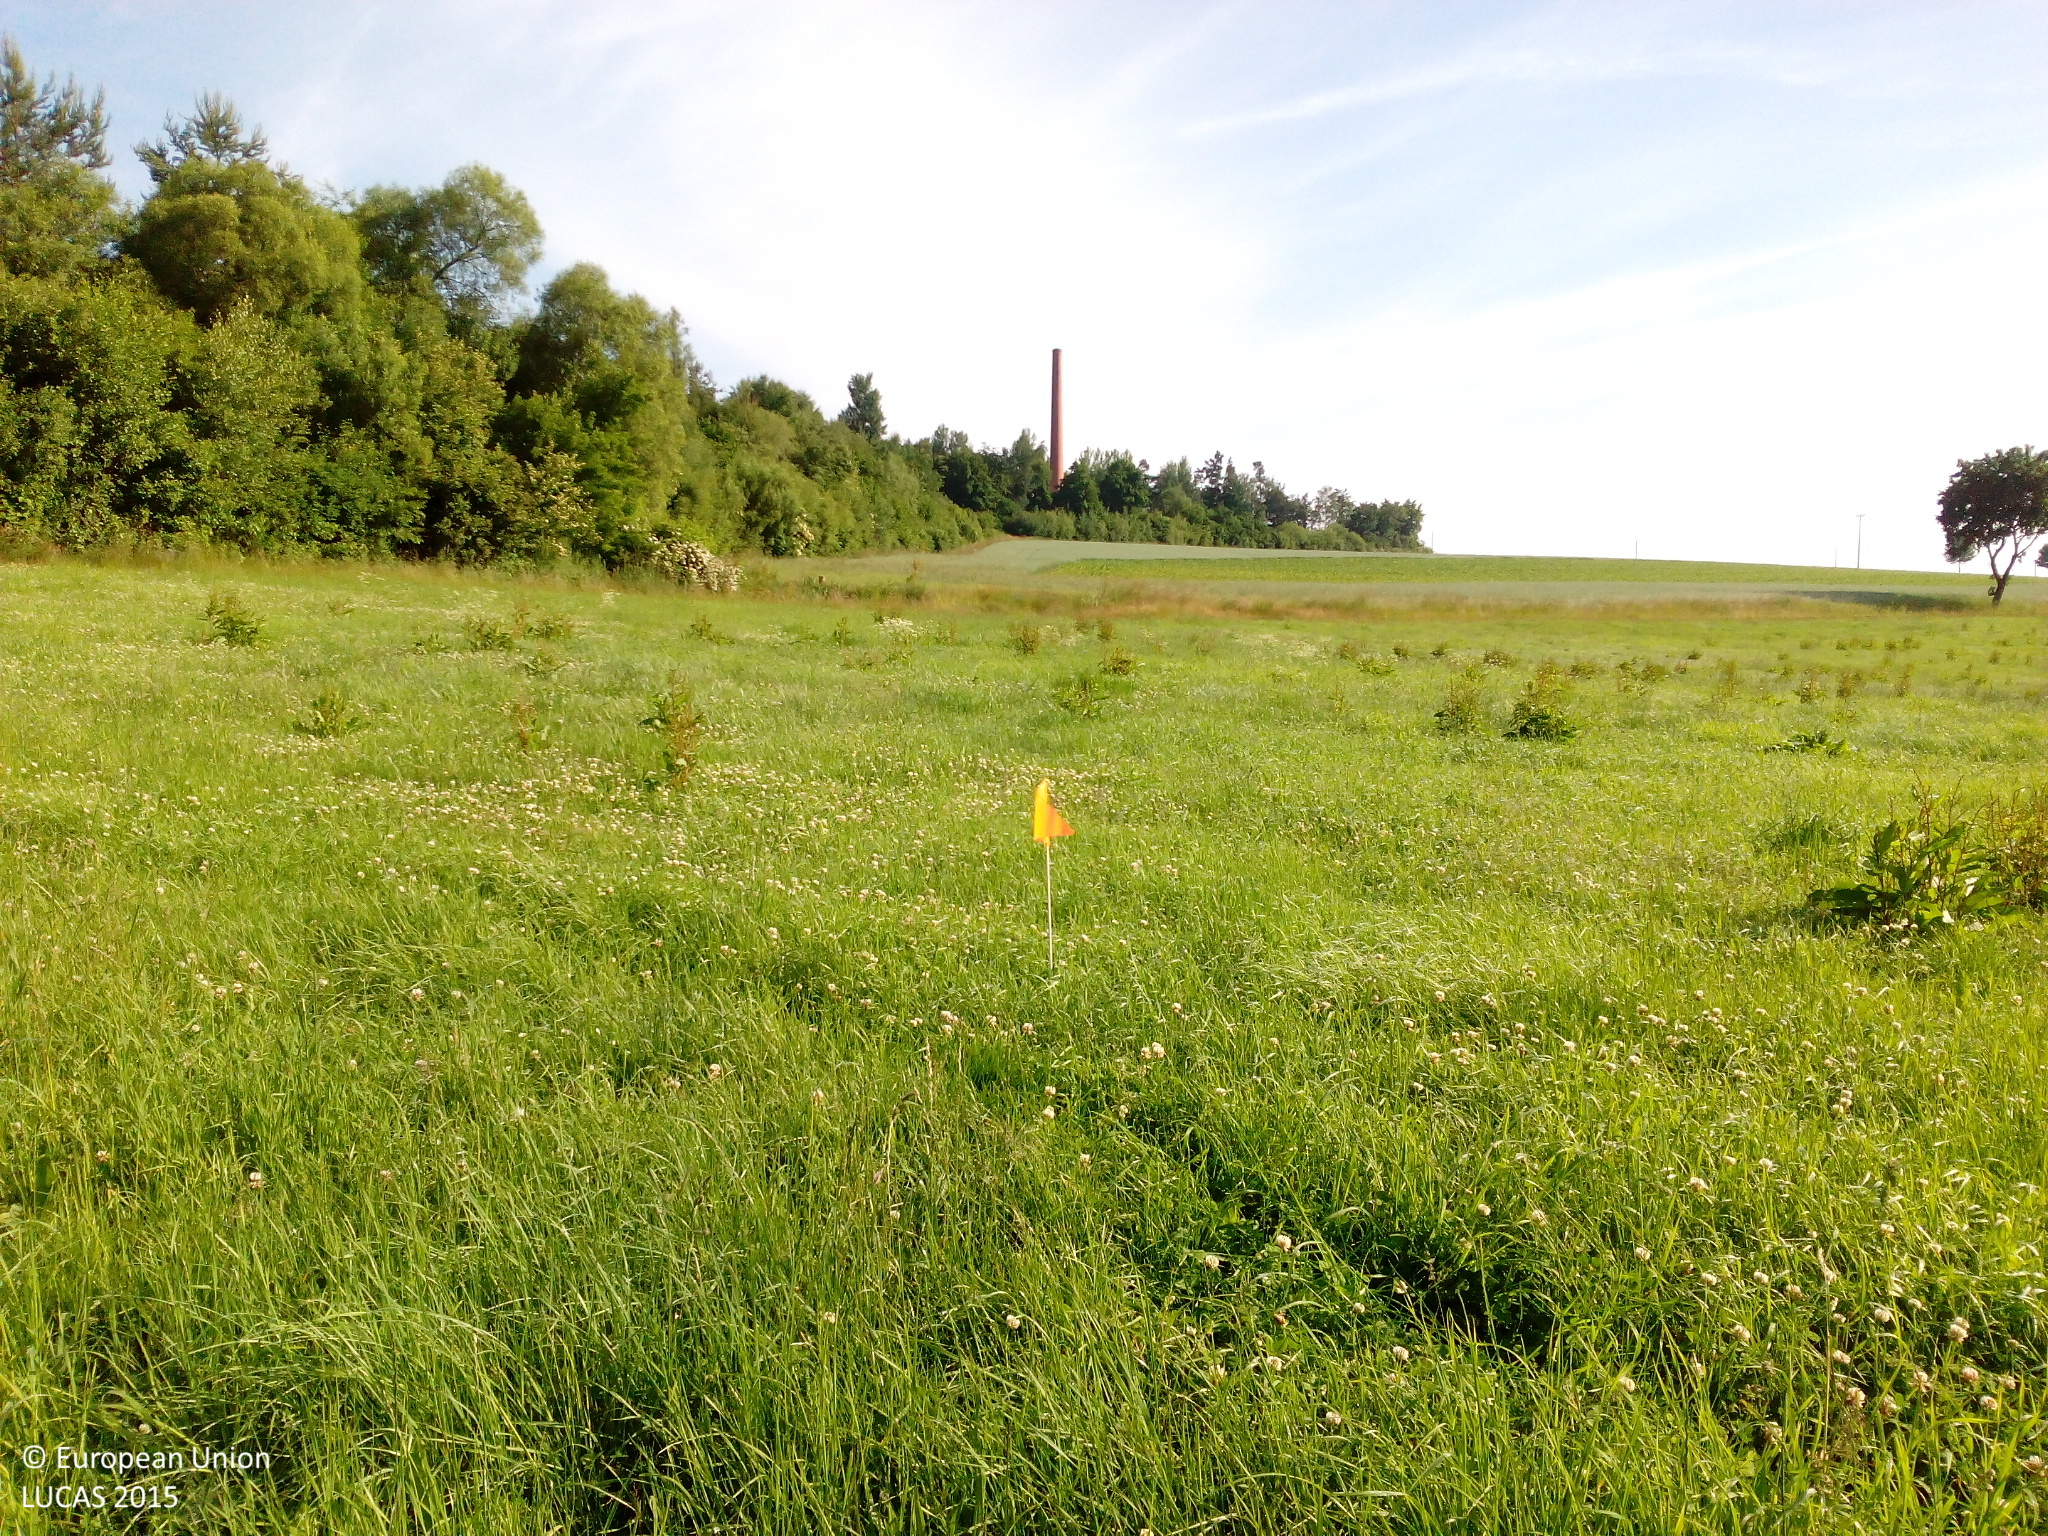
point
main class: Grassland
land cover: Grassland without tree/shrub cover
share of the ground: > 75 %
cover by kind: herbaceous plants 100 %
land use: Agriculture (excluding fallow land and kitchen gardens)
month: June
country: DE
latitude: 49.9974
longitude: 12.3852
